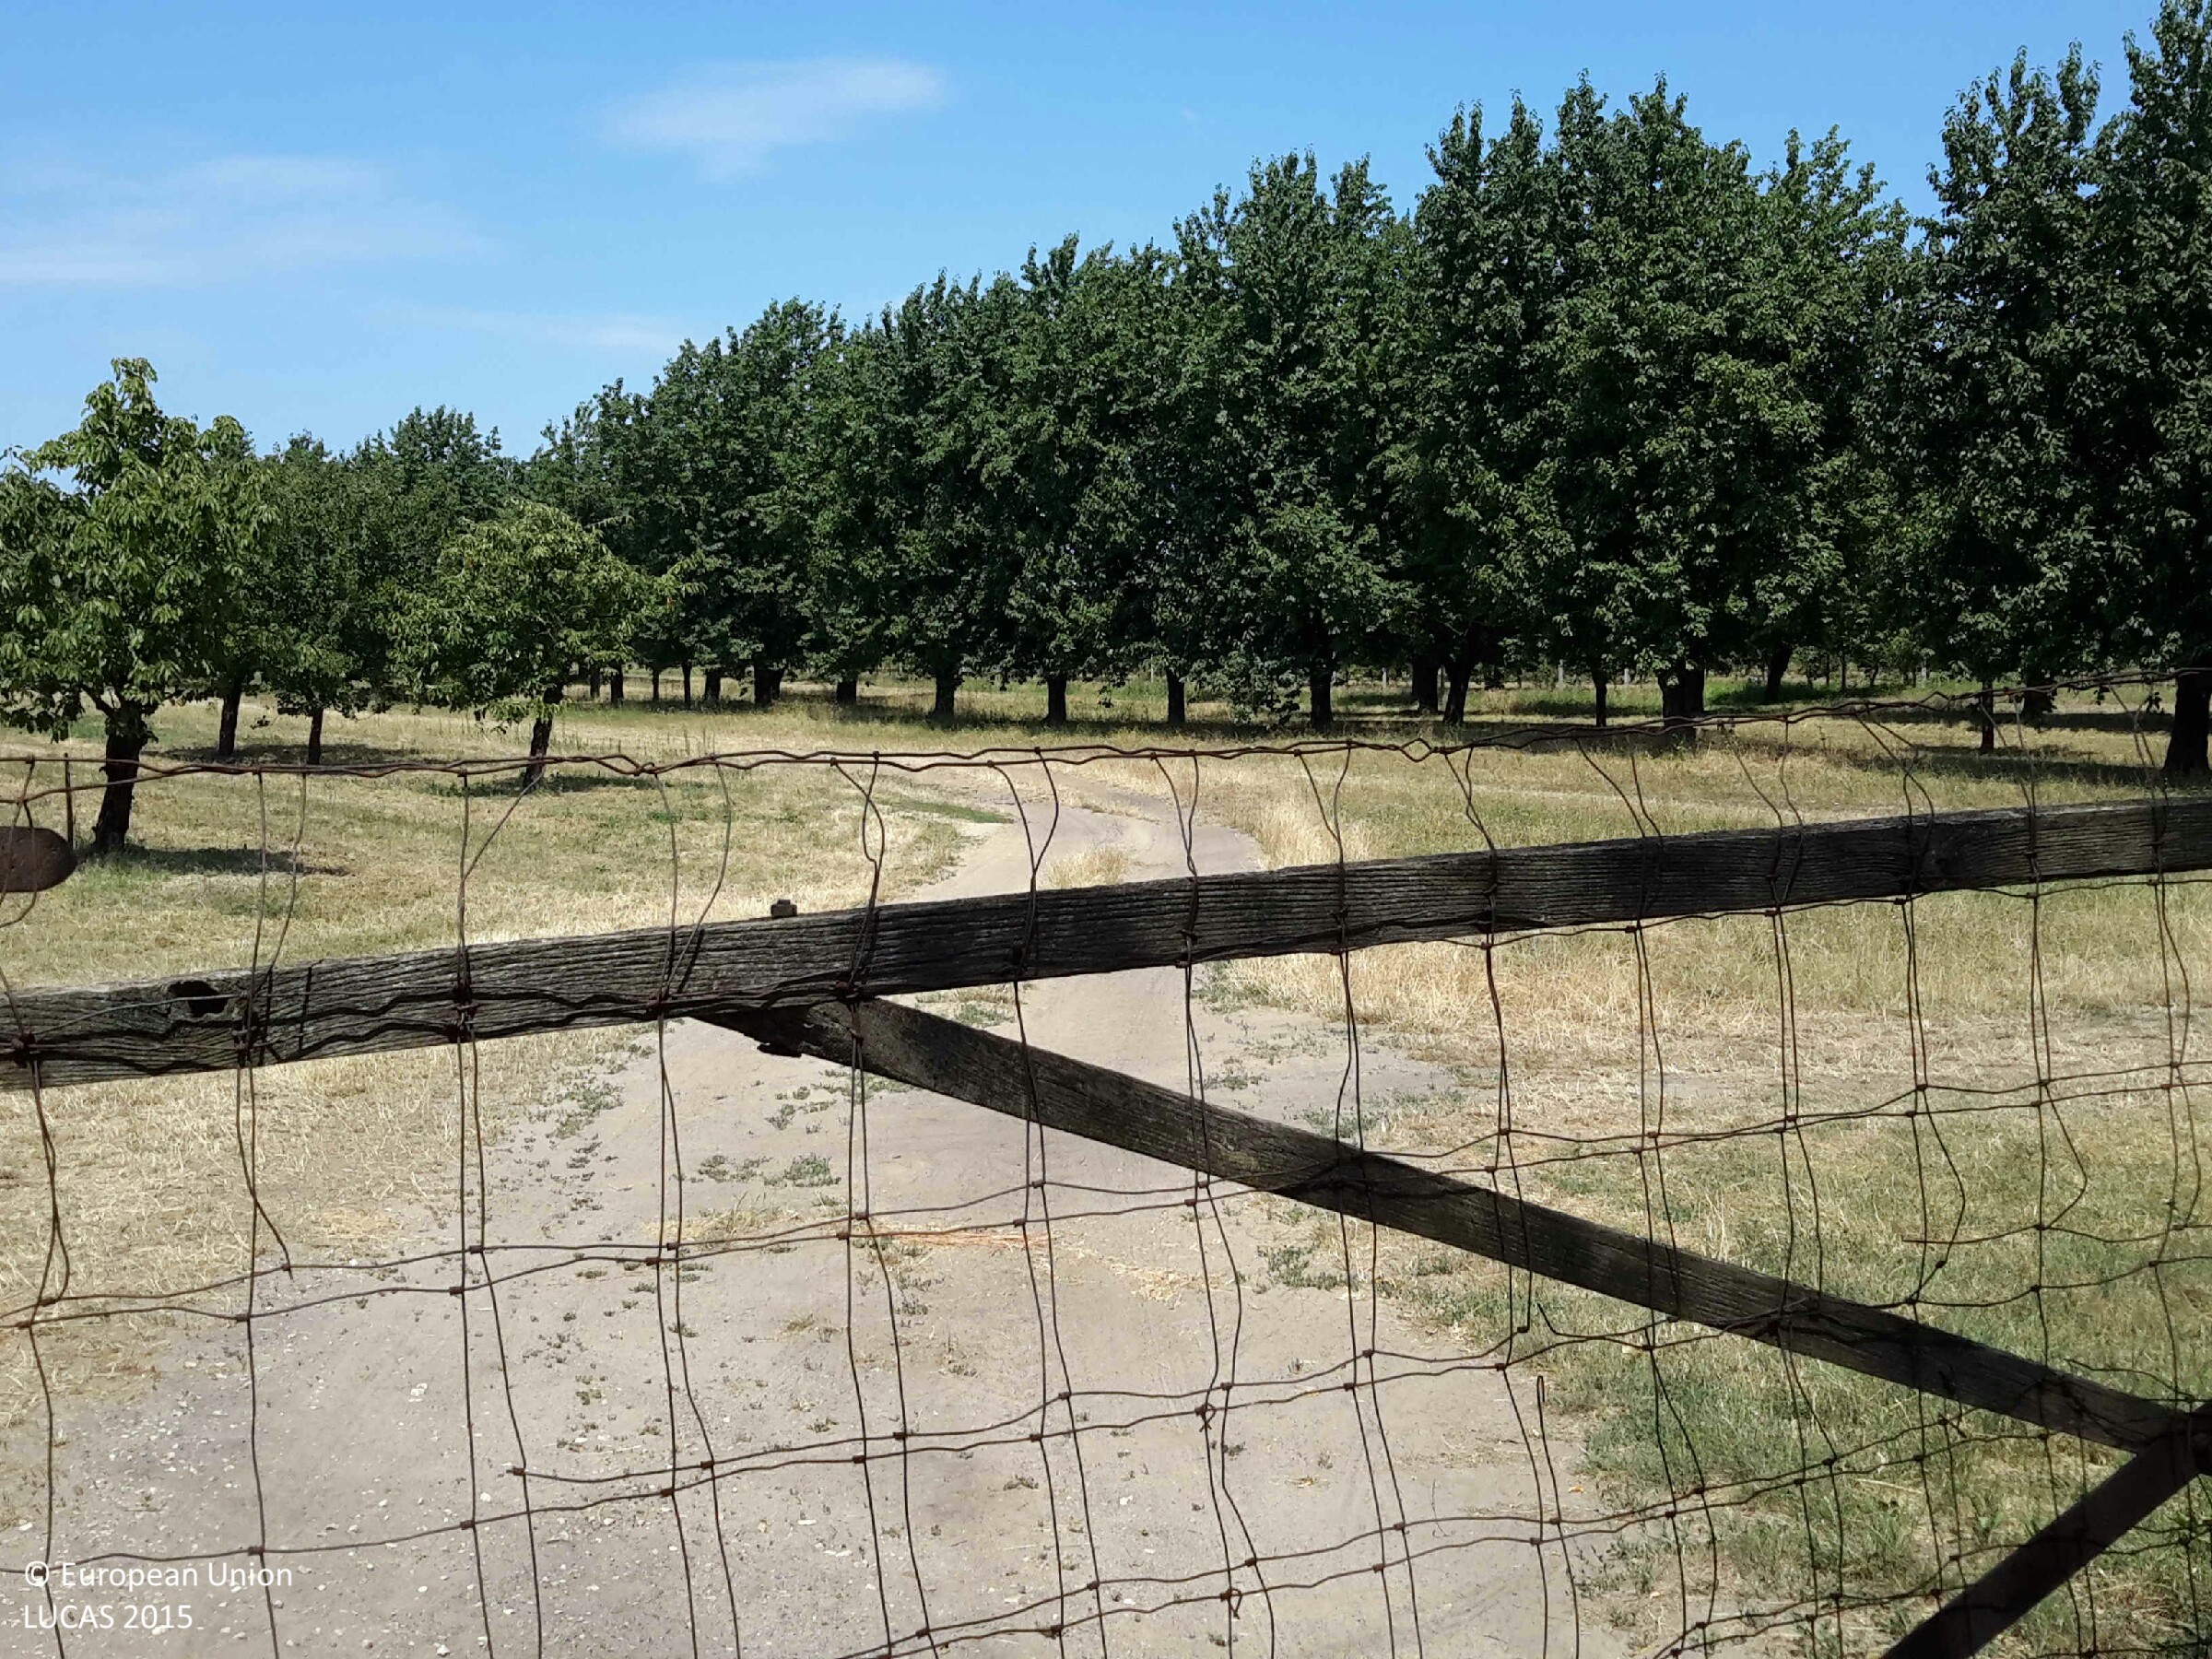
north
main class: Cropland
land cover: Permanent crops (only in case pi)
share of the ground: > 75 %
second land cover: Grassland without tree/shrub cover
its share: 50 - 75 %
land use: Agriculture (excluding fallow land and kitchen gardens)
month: July
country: HU
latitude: 47.4016
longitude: 17.8406
